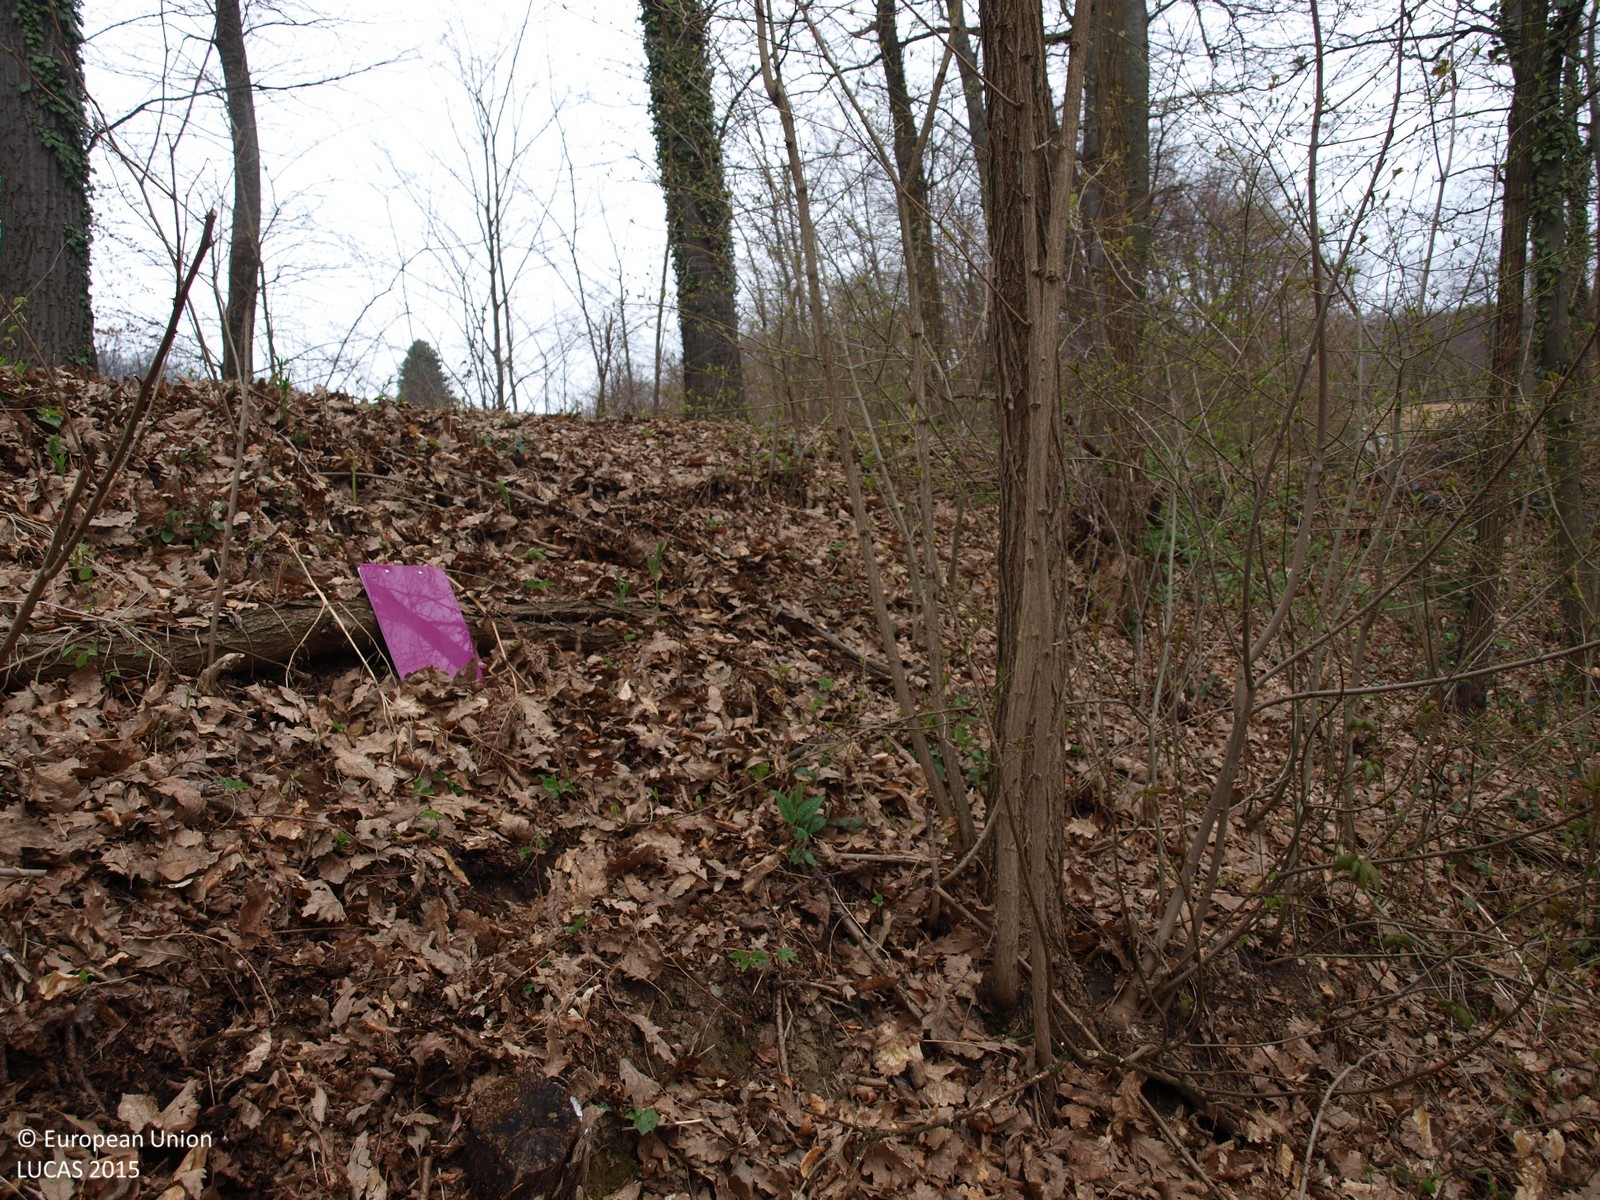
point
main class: Woodland
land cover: Broadleaved woodland
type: mesophytic deciduous forest
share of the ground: > 75 %
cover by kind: broadleaved forest trees 90 %
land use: Forestry
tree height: > 5 m
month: April
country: HR
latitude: 46.1806
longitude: 15.7113
